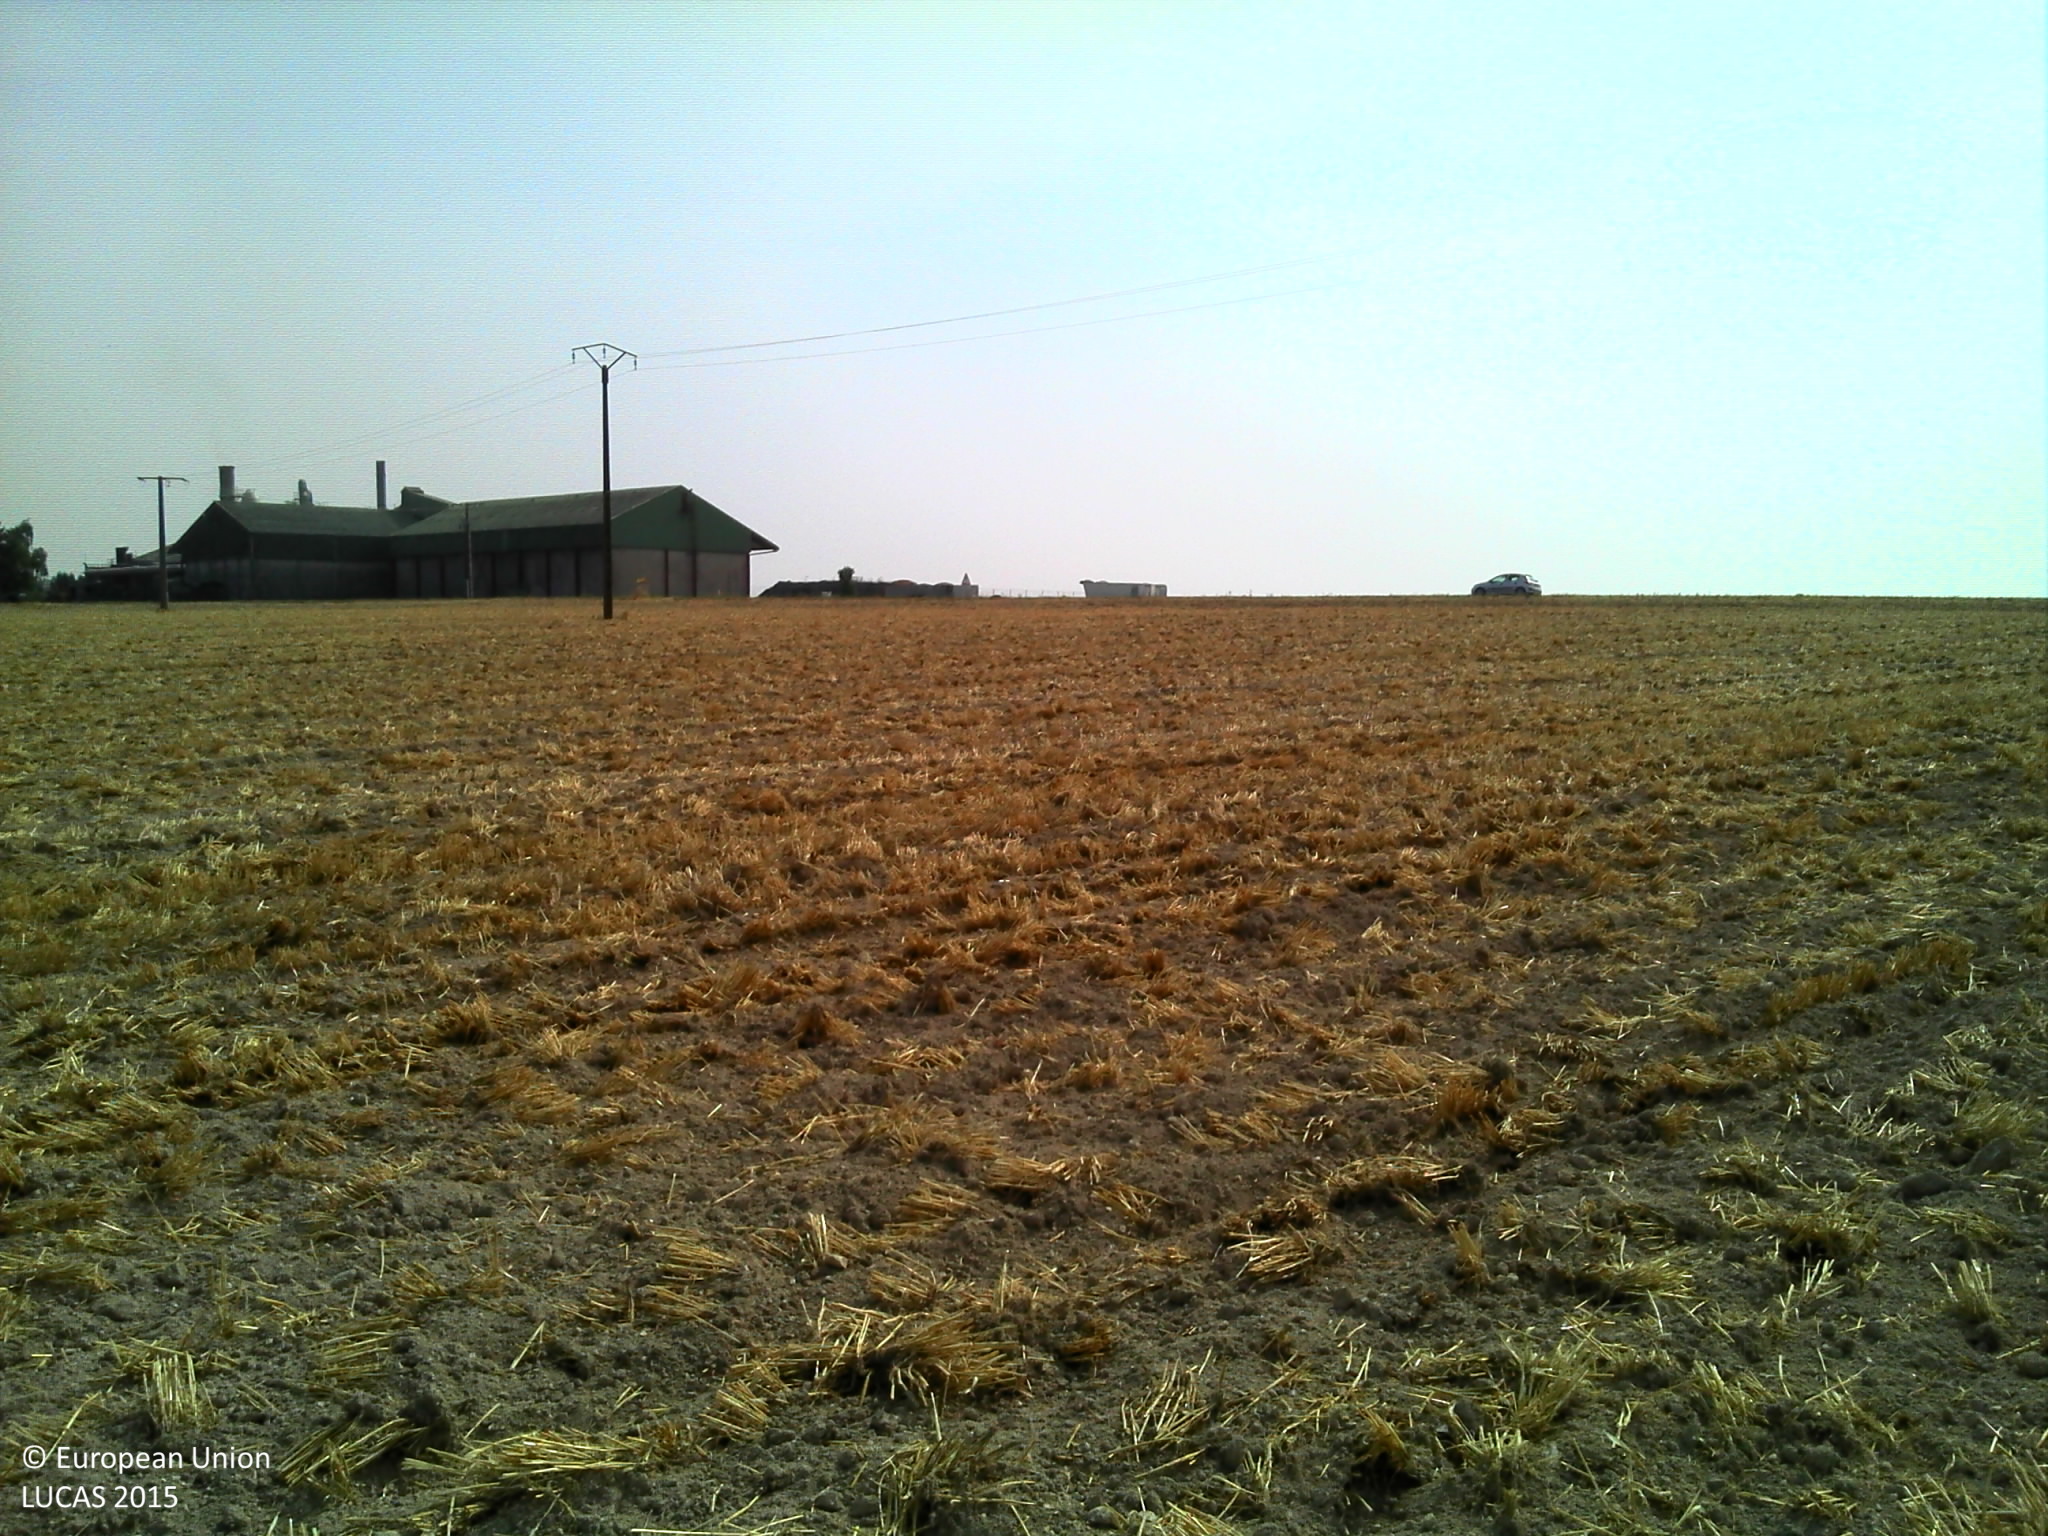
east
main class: Cropland
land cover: Common wheat
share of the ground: > 75 %
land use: Agriculture (excluding fallow land and kitchen gardens)
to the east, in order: Common wheat; Electric lines; Common wheat; Grass margins; Paved roads, cycling and walking lanes; Grass margins; Barley
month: August
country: FR
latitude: 48.7170
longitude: 4.1378
